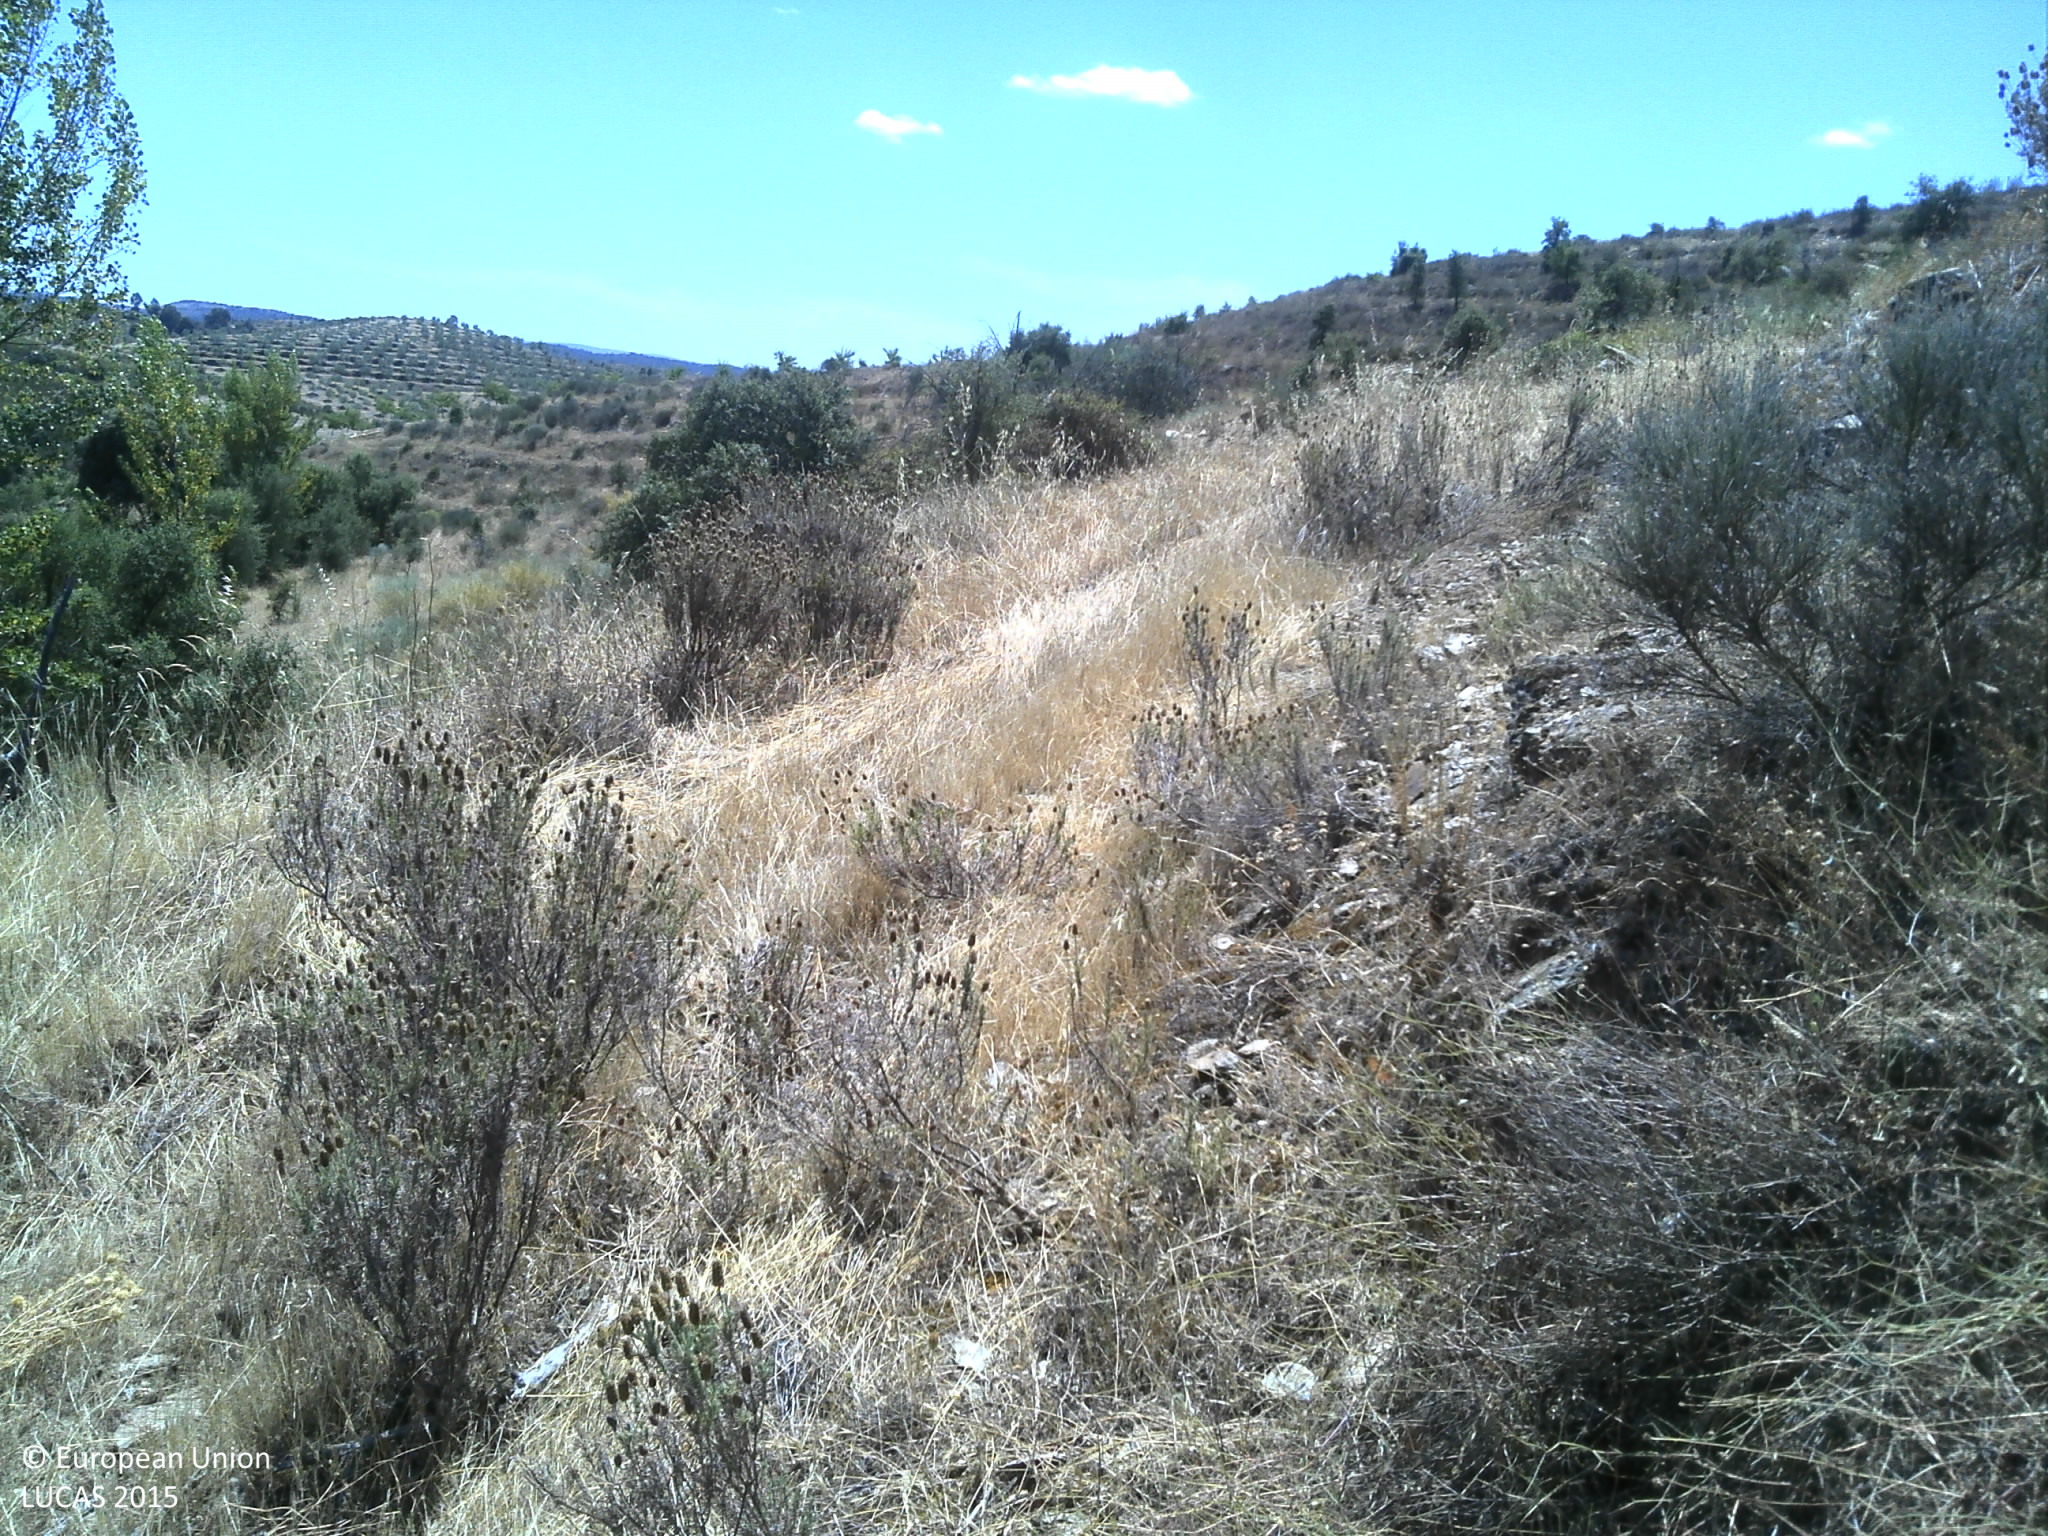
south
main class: Shrubland
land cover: Shrubland with sparse tree cover
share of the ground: > 75 %
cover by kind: shrubs 65 %, unconsolidated bare surface 20 %, herbaceous plants 10 %, broadleaved forest trees 5 %
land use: Abandoned areas
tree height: > 5 m
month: July
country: PT
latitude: 41.3652
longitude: -7.0291
